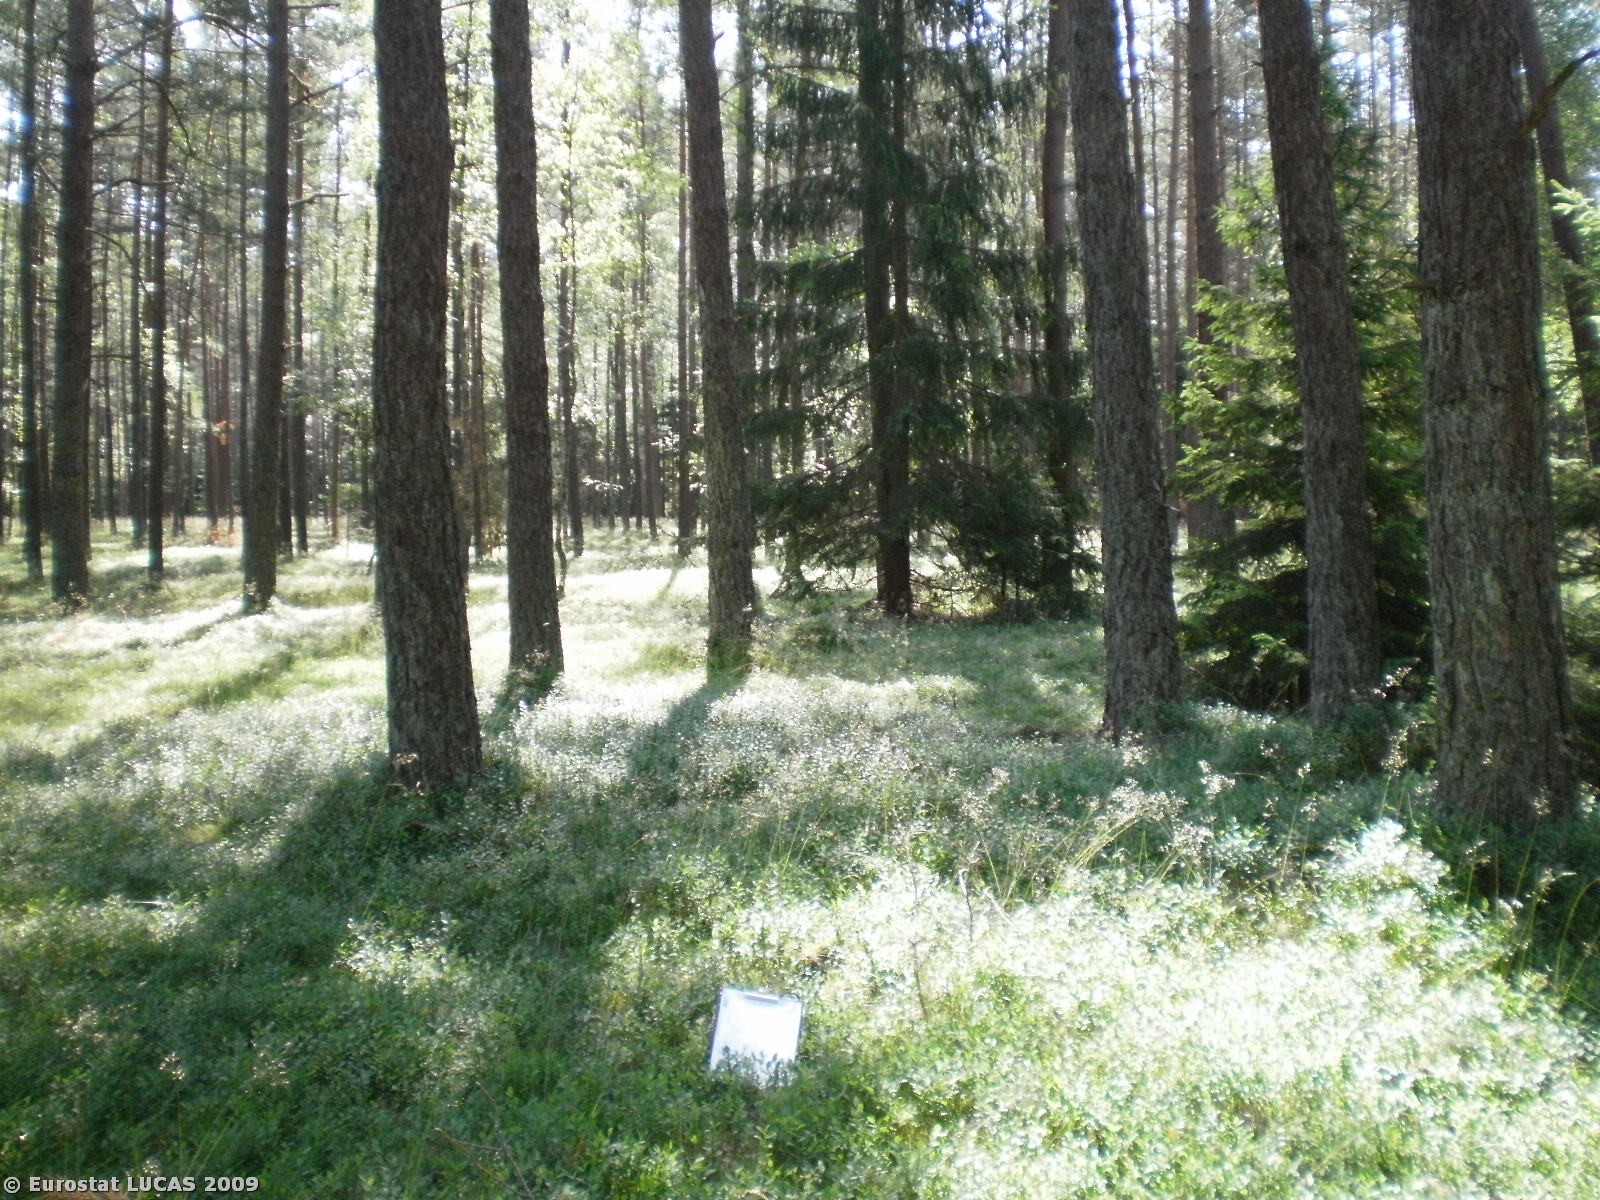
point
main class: Woodland
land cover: Coniferous woodland
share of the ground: > 75 %
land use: Forestry
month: July
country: PL
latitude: 54.2663
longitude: 17.2719
